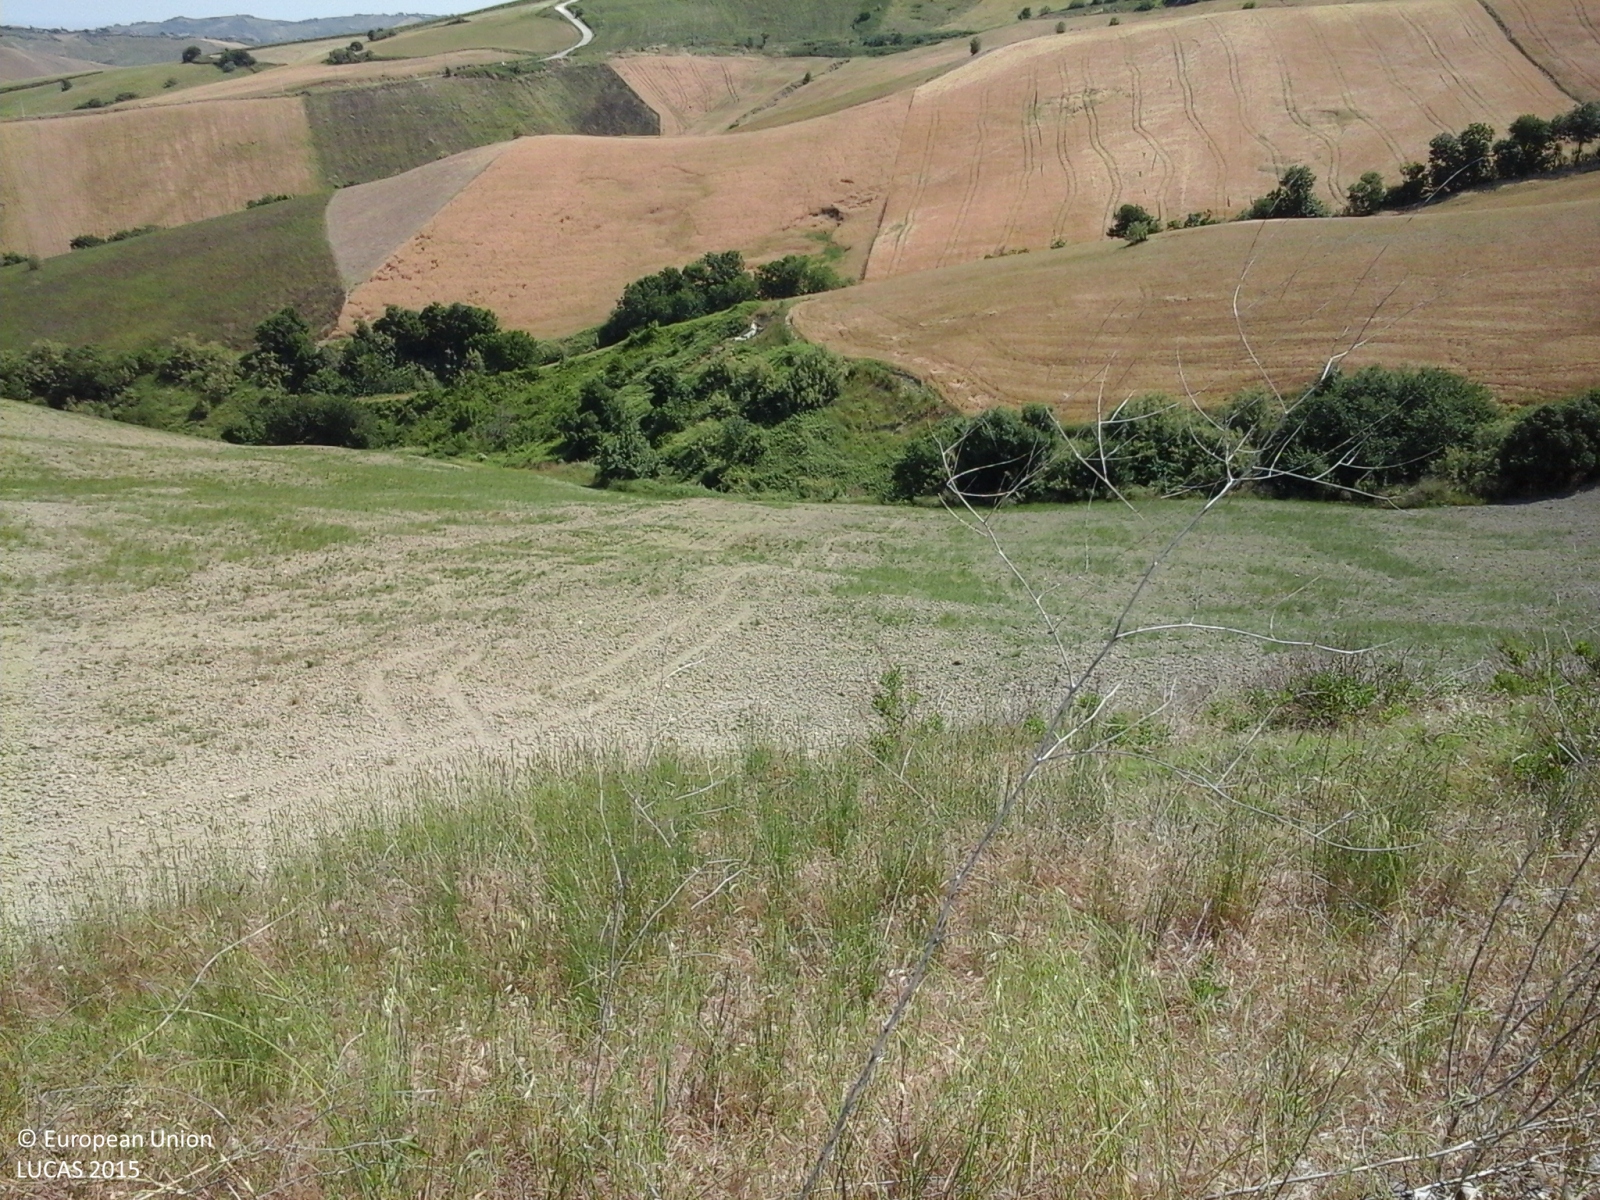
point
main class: Cropland
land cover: Other non-permanent industrial crops
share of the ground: 25 - 50 %
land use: Agriculture (excluding fallow land and kitchen gardens)
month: May
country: IT
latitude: 42.1020
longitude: 14.4963
